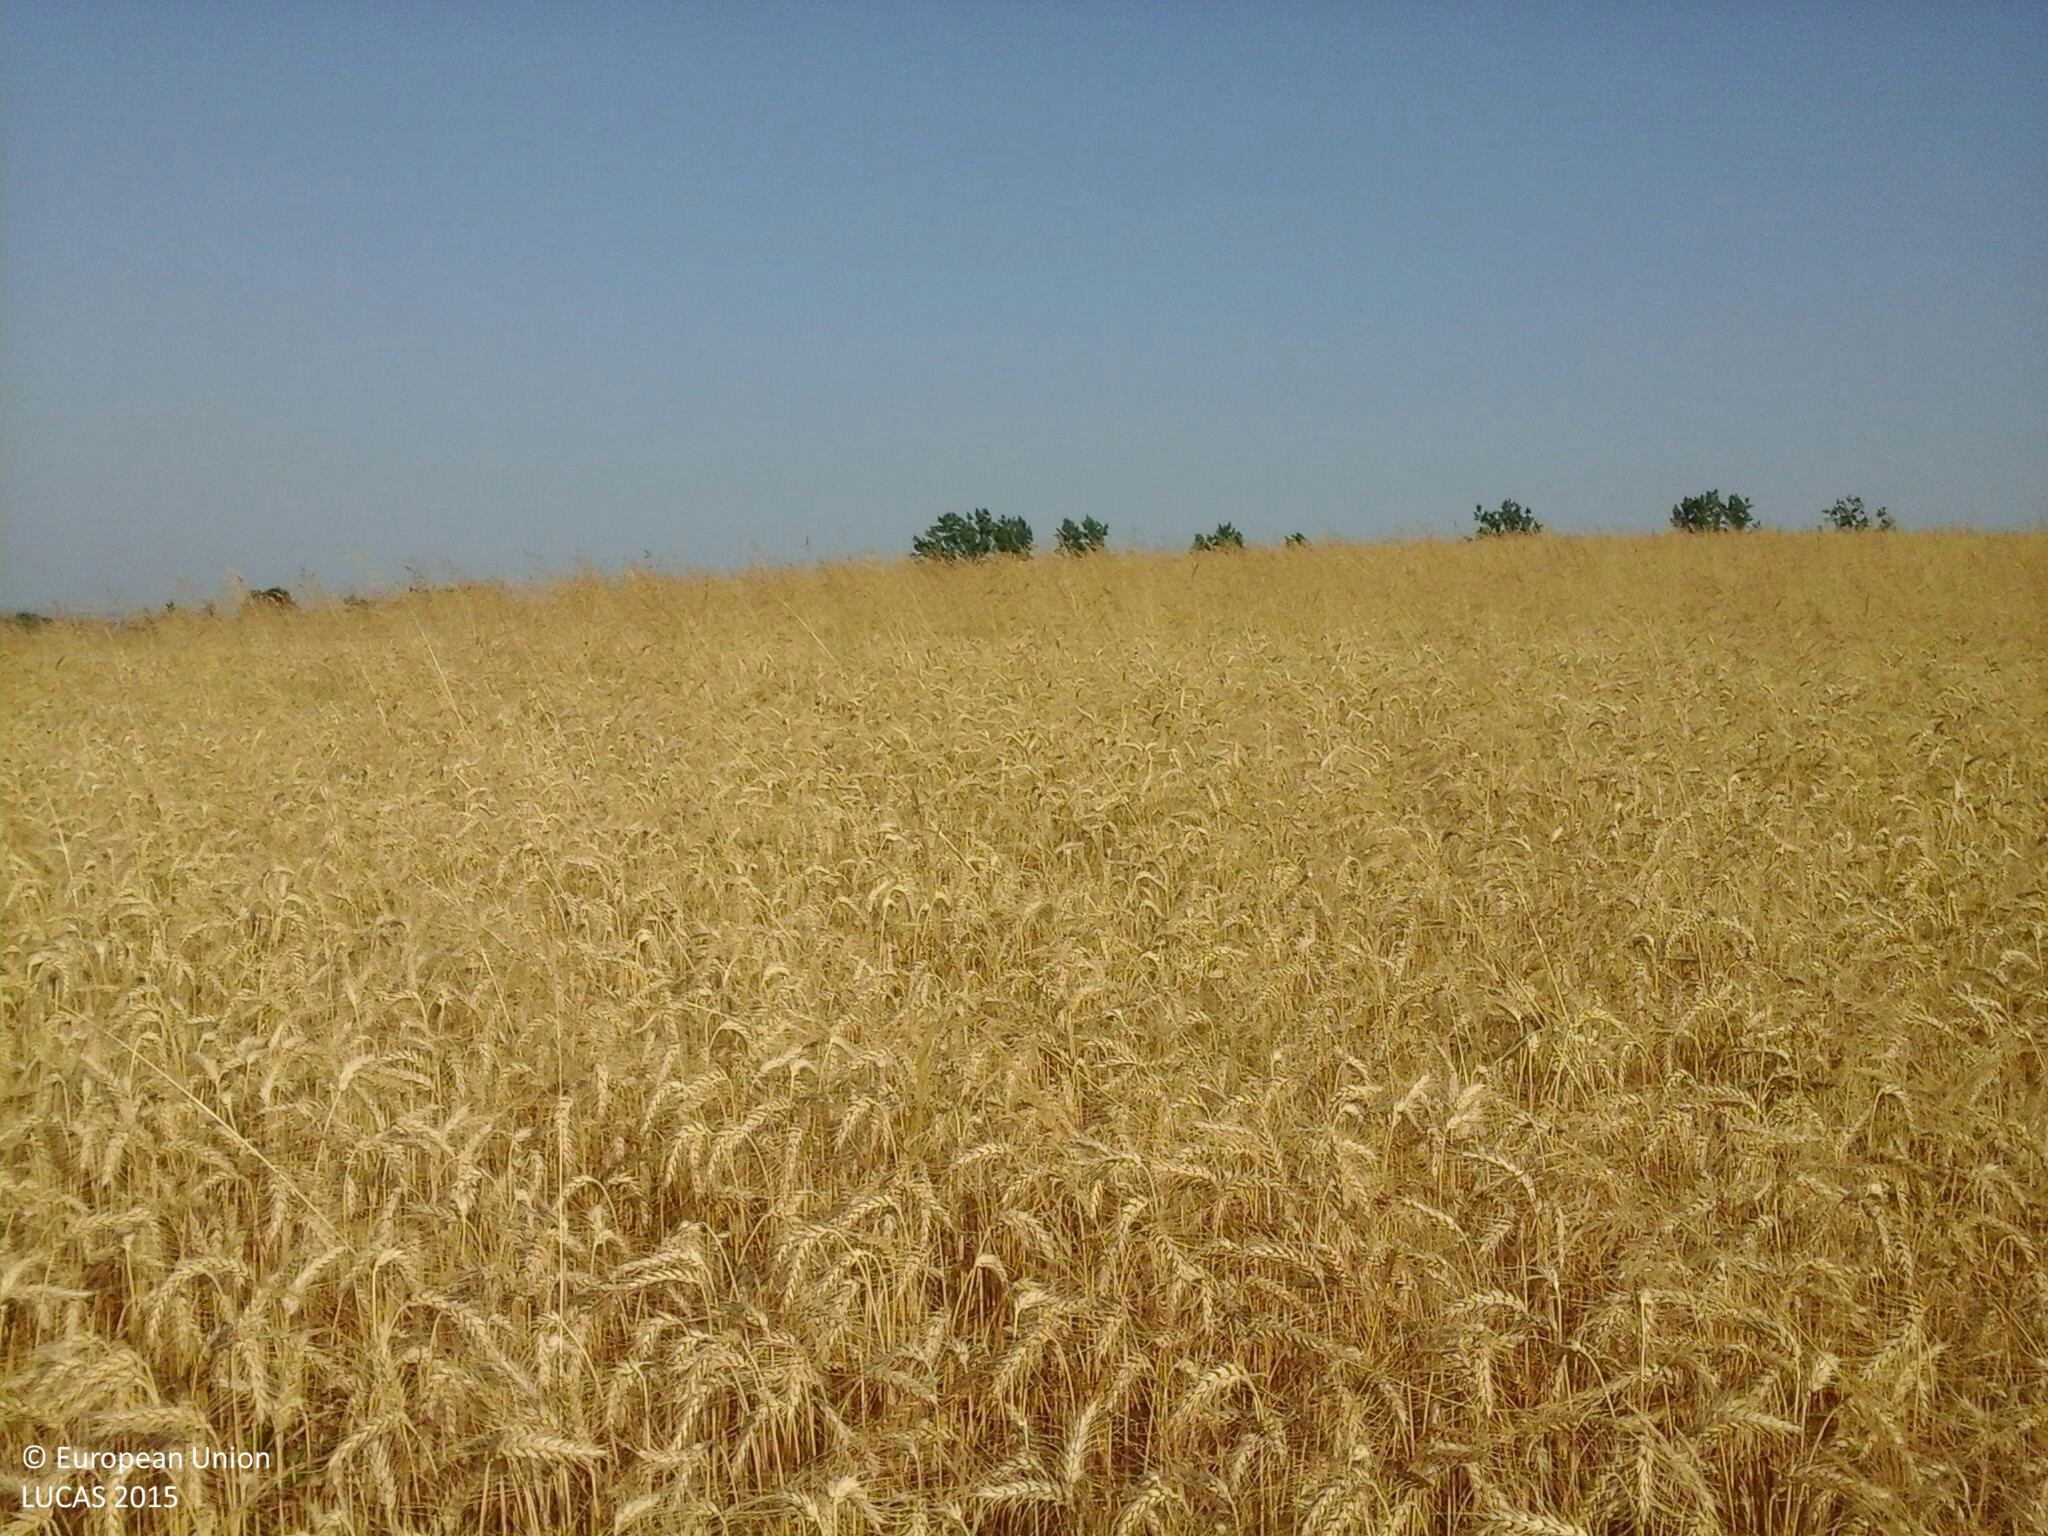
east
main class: Cropland
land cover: Common wheat
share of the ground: > 75 %
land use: Agriculture (excluding fallow land and kitchen gardens)
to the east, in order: Common wheat; Grassland without tree/shrub cover; Single bushes/trees; Electric lines; Grassland without tree/shrub cover; Common wheat; Tracks; Grass margins; Common wheat
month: July
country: HU
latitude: 47.1628
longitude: 17.3803
